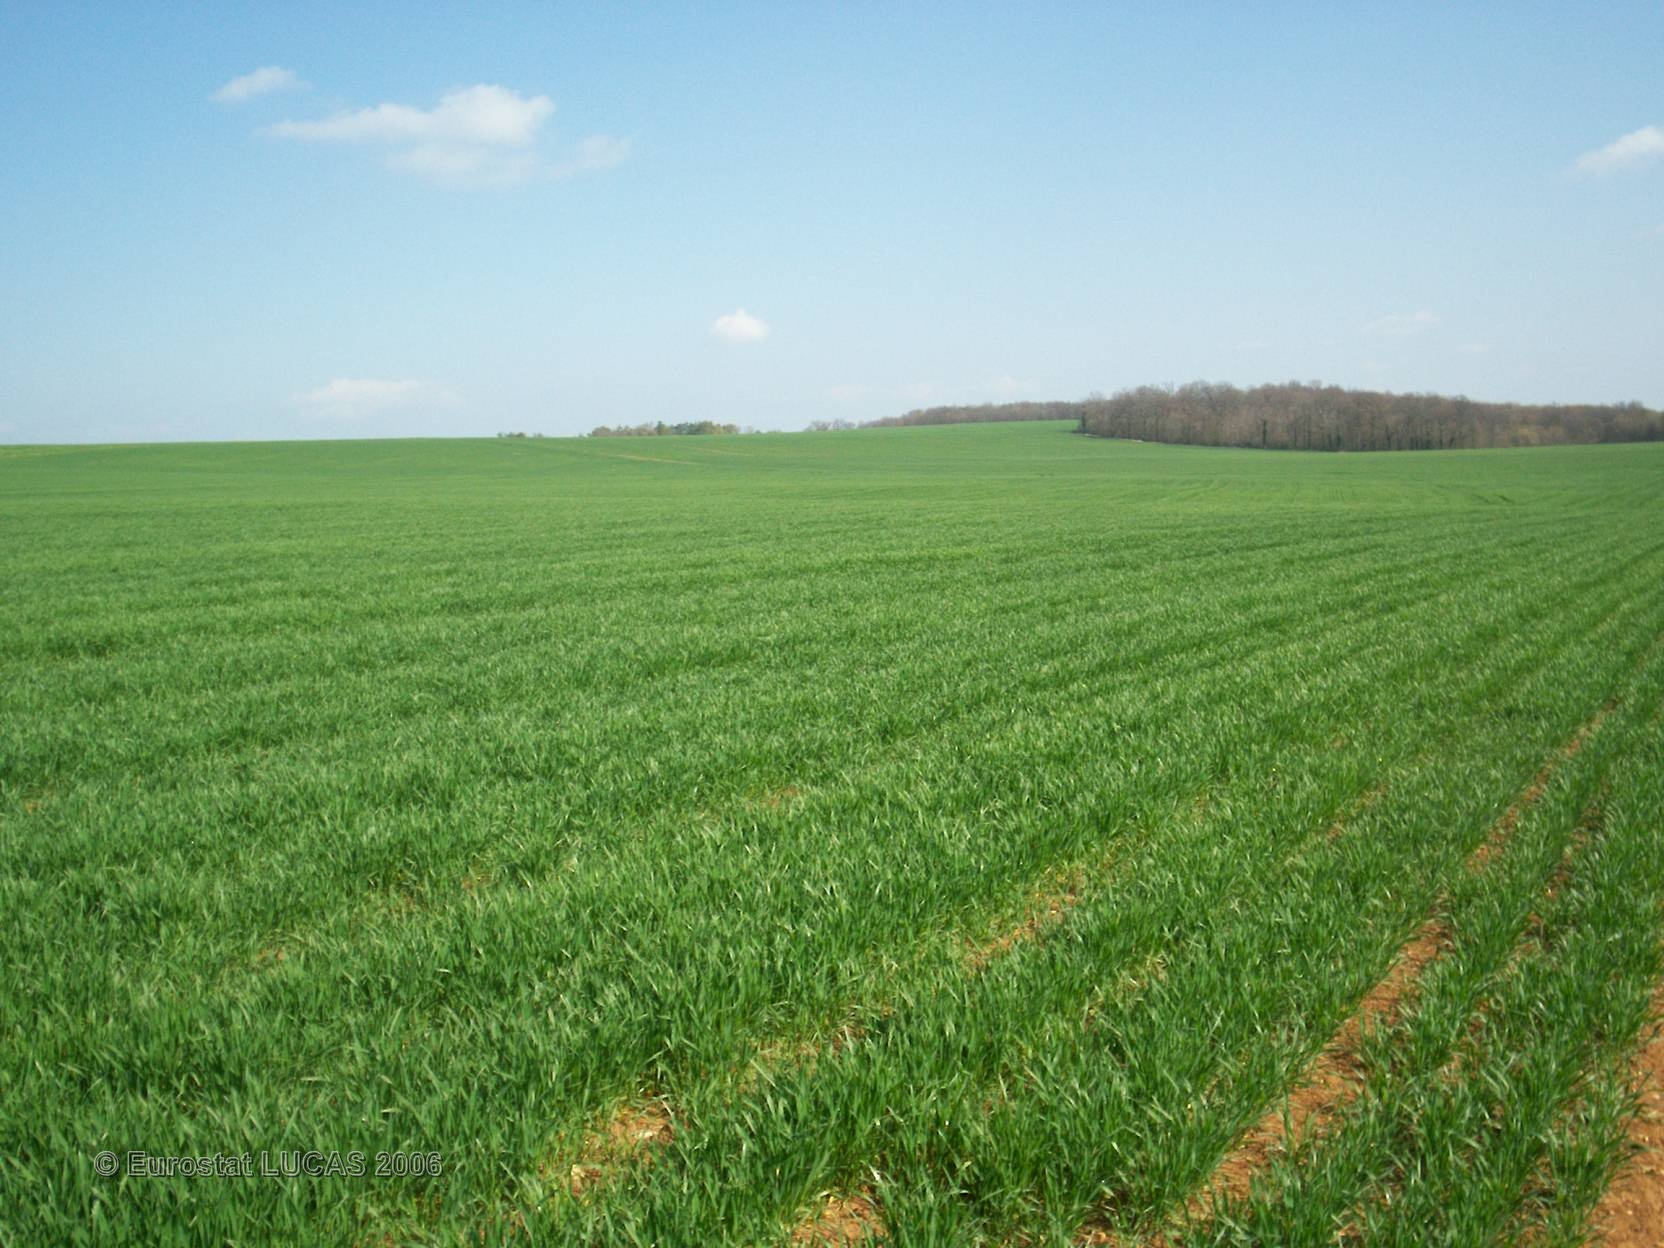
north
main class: Cropland
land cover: Common wheat
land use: Agriculture (excluding fallow land and kitchen gardens)
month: April
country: FR
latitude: 47.4394
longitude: 4.5495
